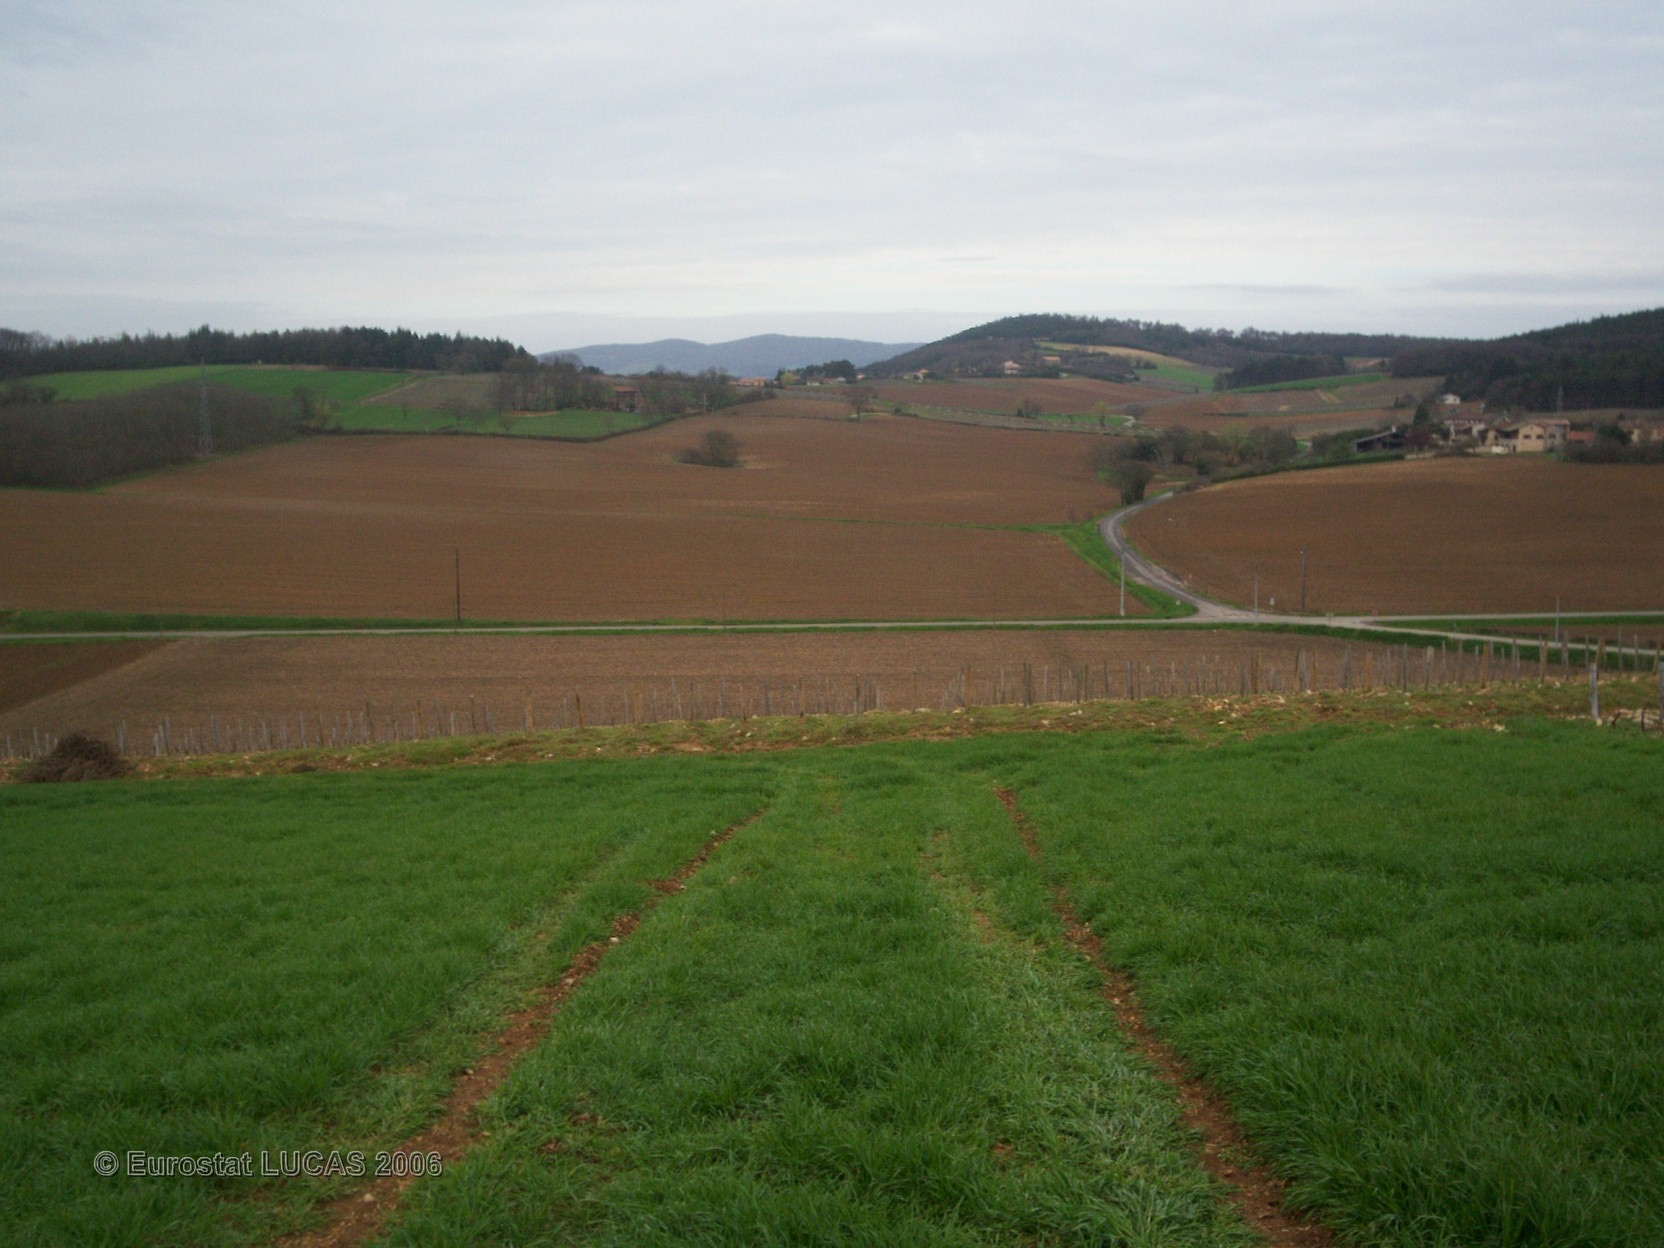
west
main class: Cropland
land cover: Barley
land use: Agriculture (excluding fallow land and kitchen gardens)
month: April
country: FR
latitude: 46.3494
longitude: 4.7653
